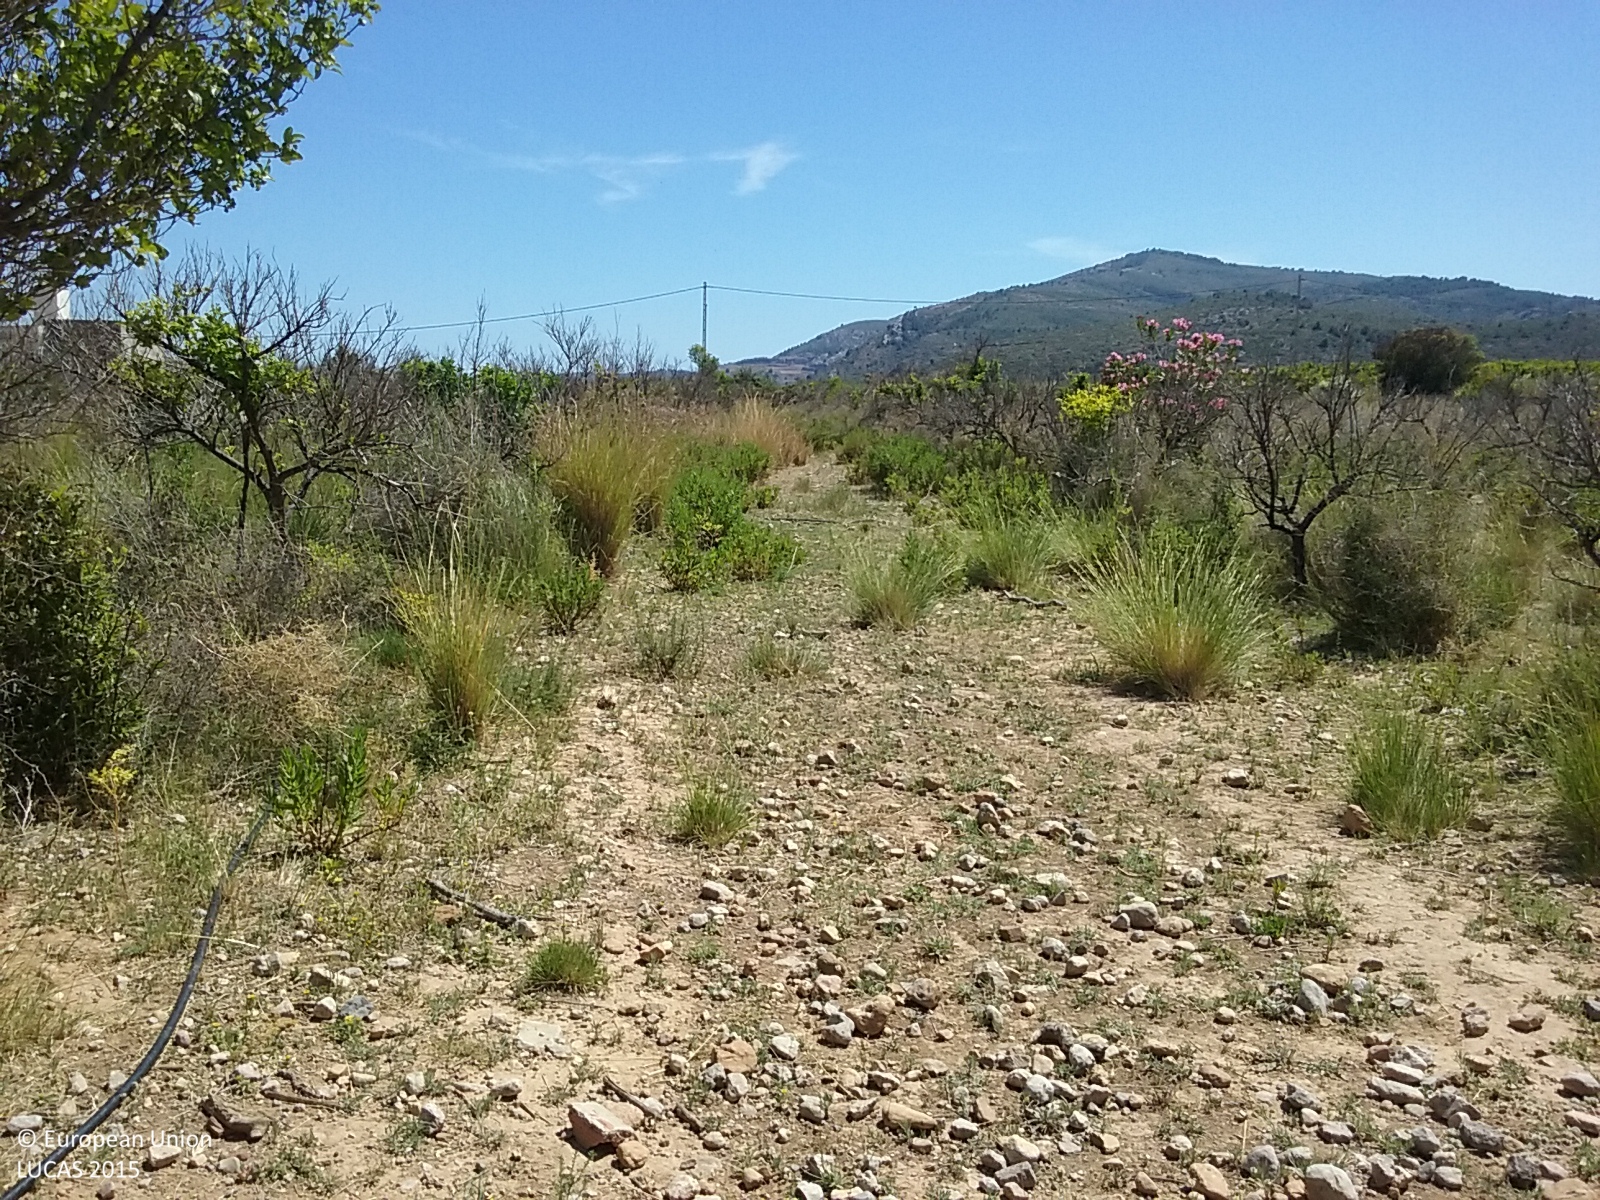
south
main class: Cropland
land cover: Other citrus fruit
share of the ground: < 10 %
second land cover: Grassland without tree/shrub cover
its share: 25 - 50 %
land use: Abandoned areas
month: June
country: ES
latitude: 40.1326
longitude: 0.1283
